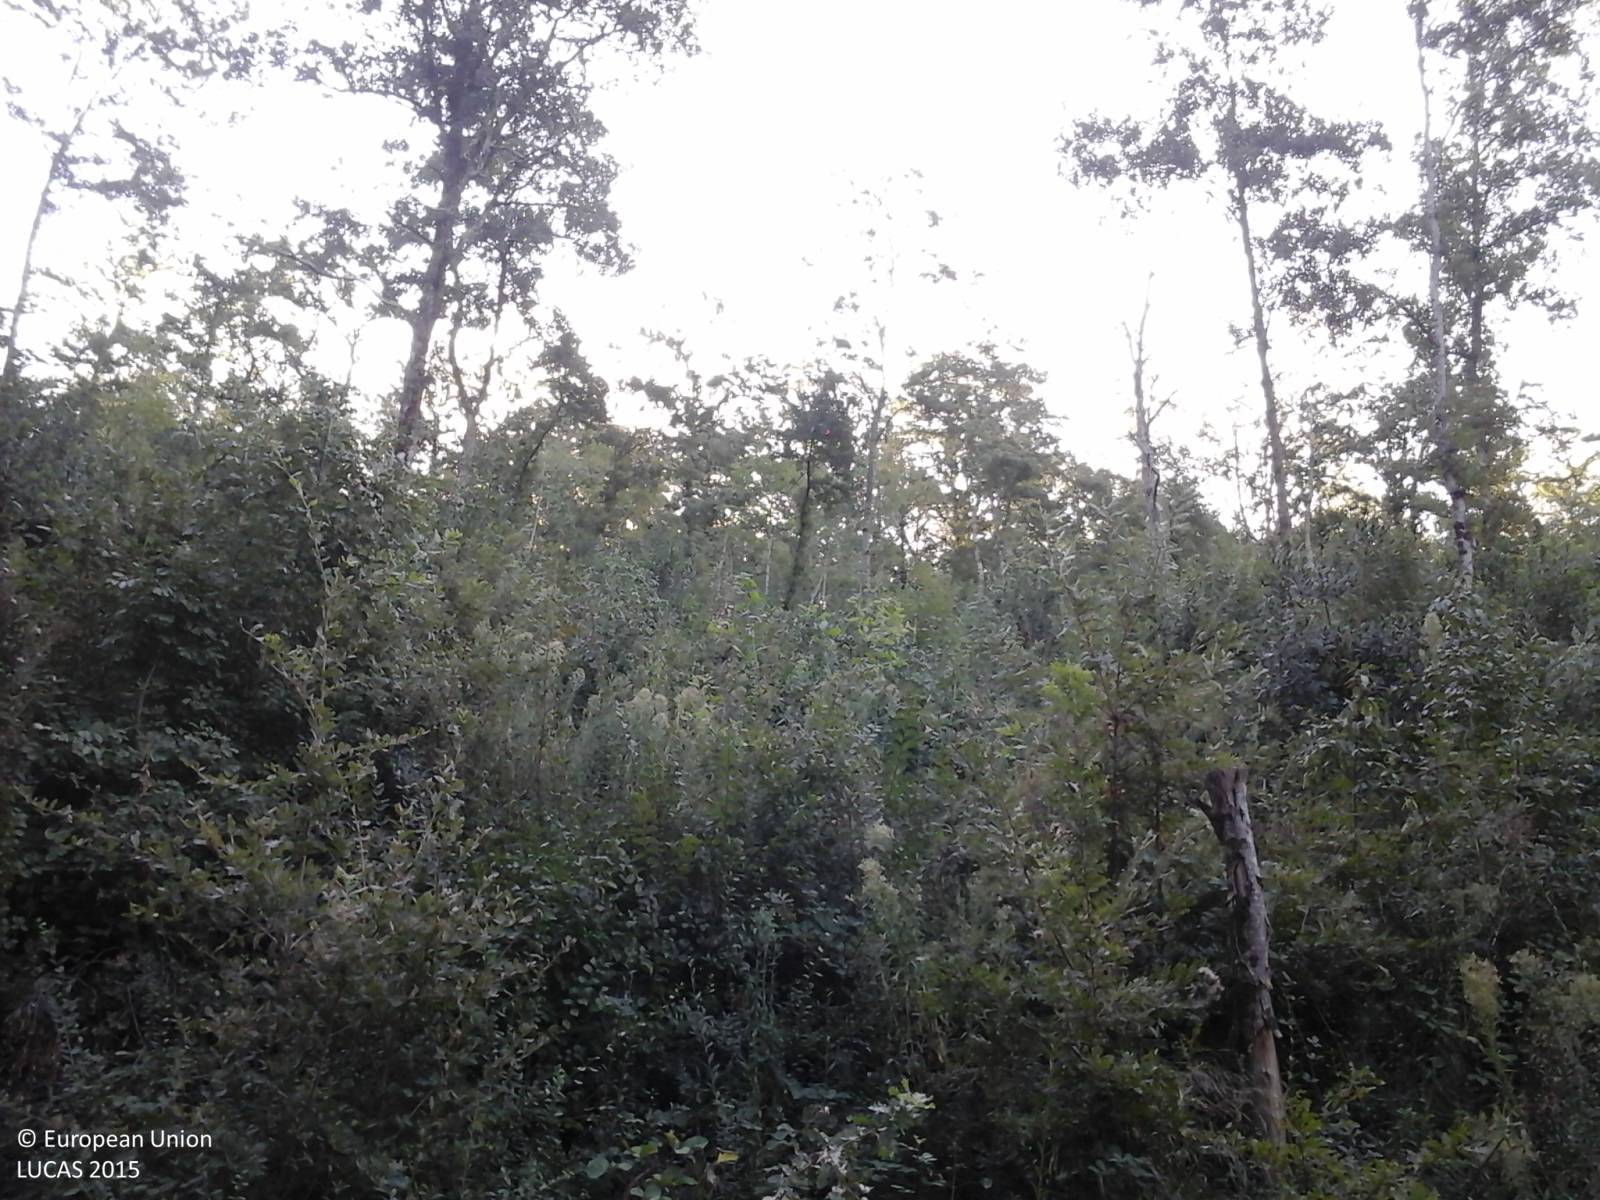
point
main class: Woodland
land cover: Broadleaved woodland
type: mesophytic deciduous forest
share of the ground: > 75 %
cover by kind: broadleaved forest trees 85 %, shrubs 15 %
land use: Forestry
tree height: > 5 m
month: September
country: IT
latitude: 43.1502
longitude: 12.3665
